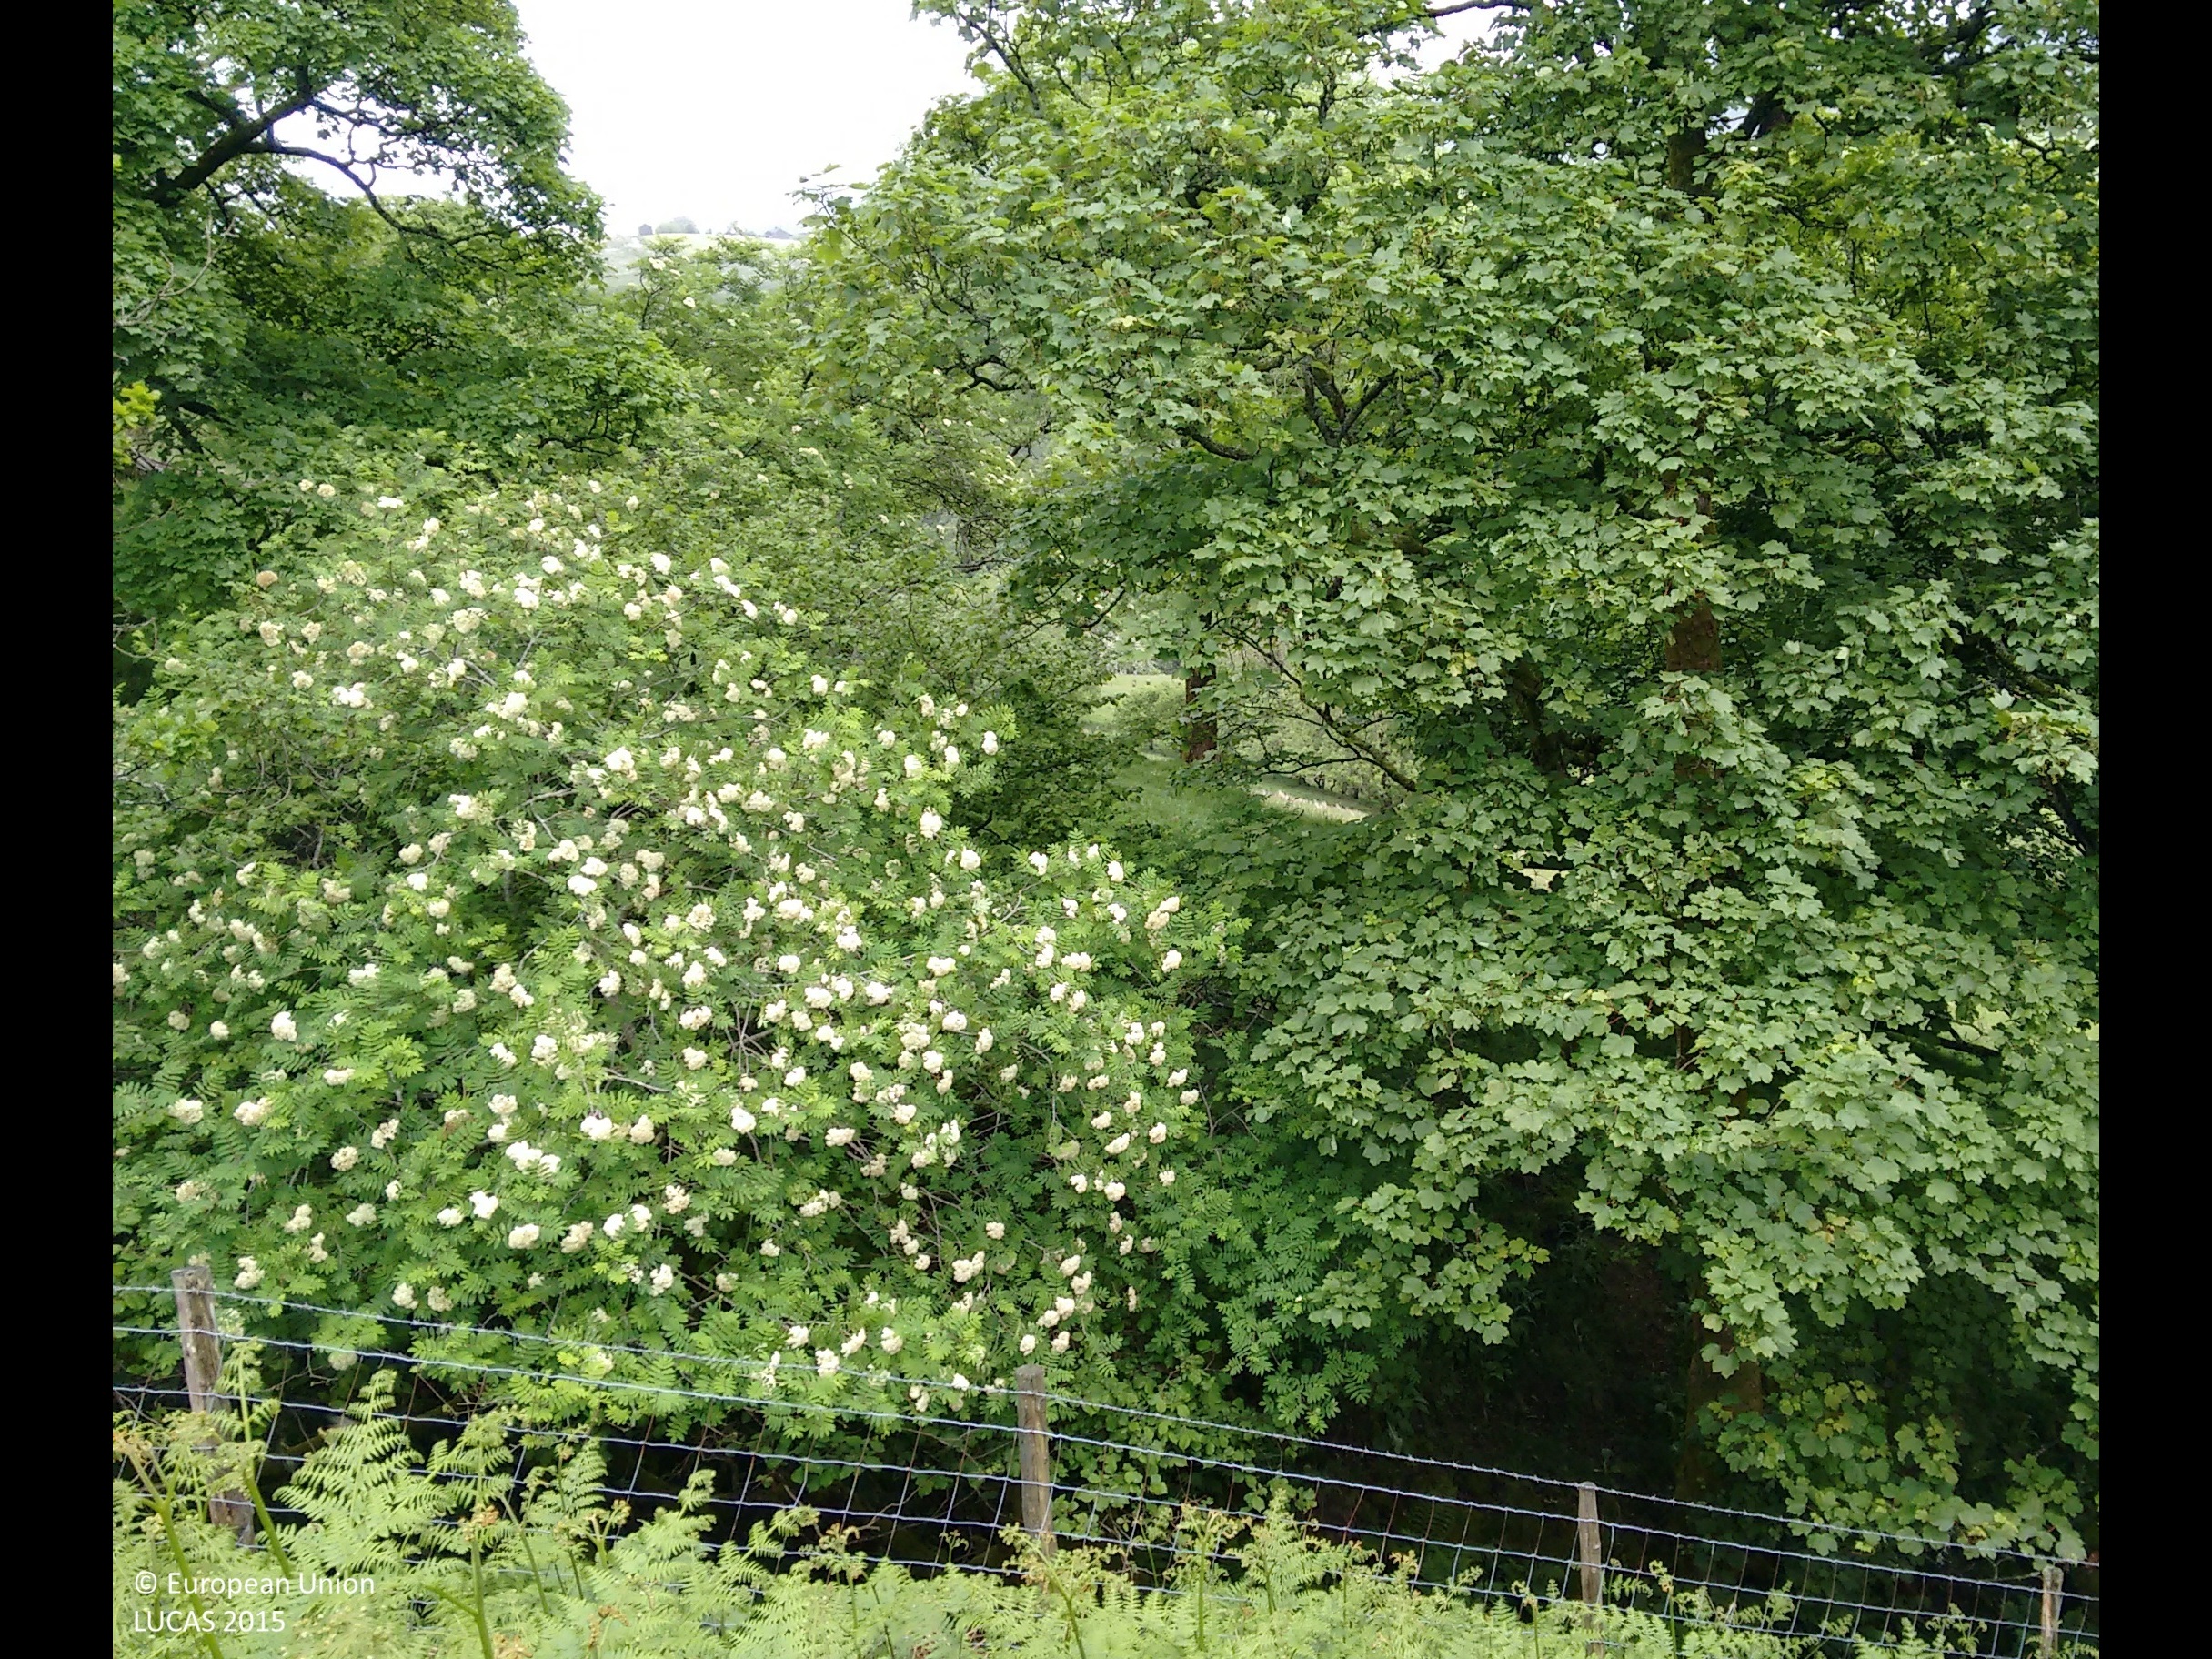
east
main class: Grassland
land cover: Spontaneously vegetated surfaces
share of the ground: > 75 %
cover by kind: herbaceous plants 100 %
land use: Semi-natural and natural areas not in use
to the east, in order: Spontaneously vegetated surfaces; Fences; Broadleaved woodland; Rivers and streams; Broadleaved woodland; Grassland without tree/shrub cover; Lines of trees; Grassland without tree/shrub cover
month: June
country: GB
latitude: 54.3759
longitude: -2.4561
